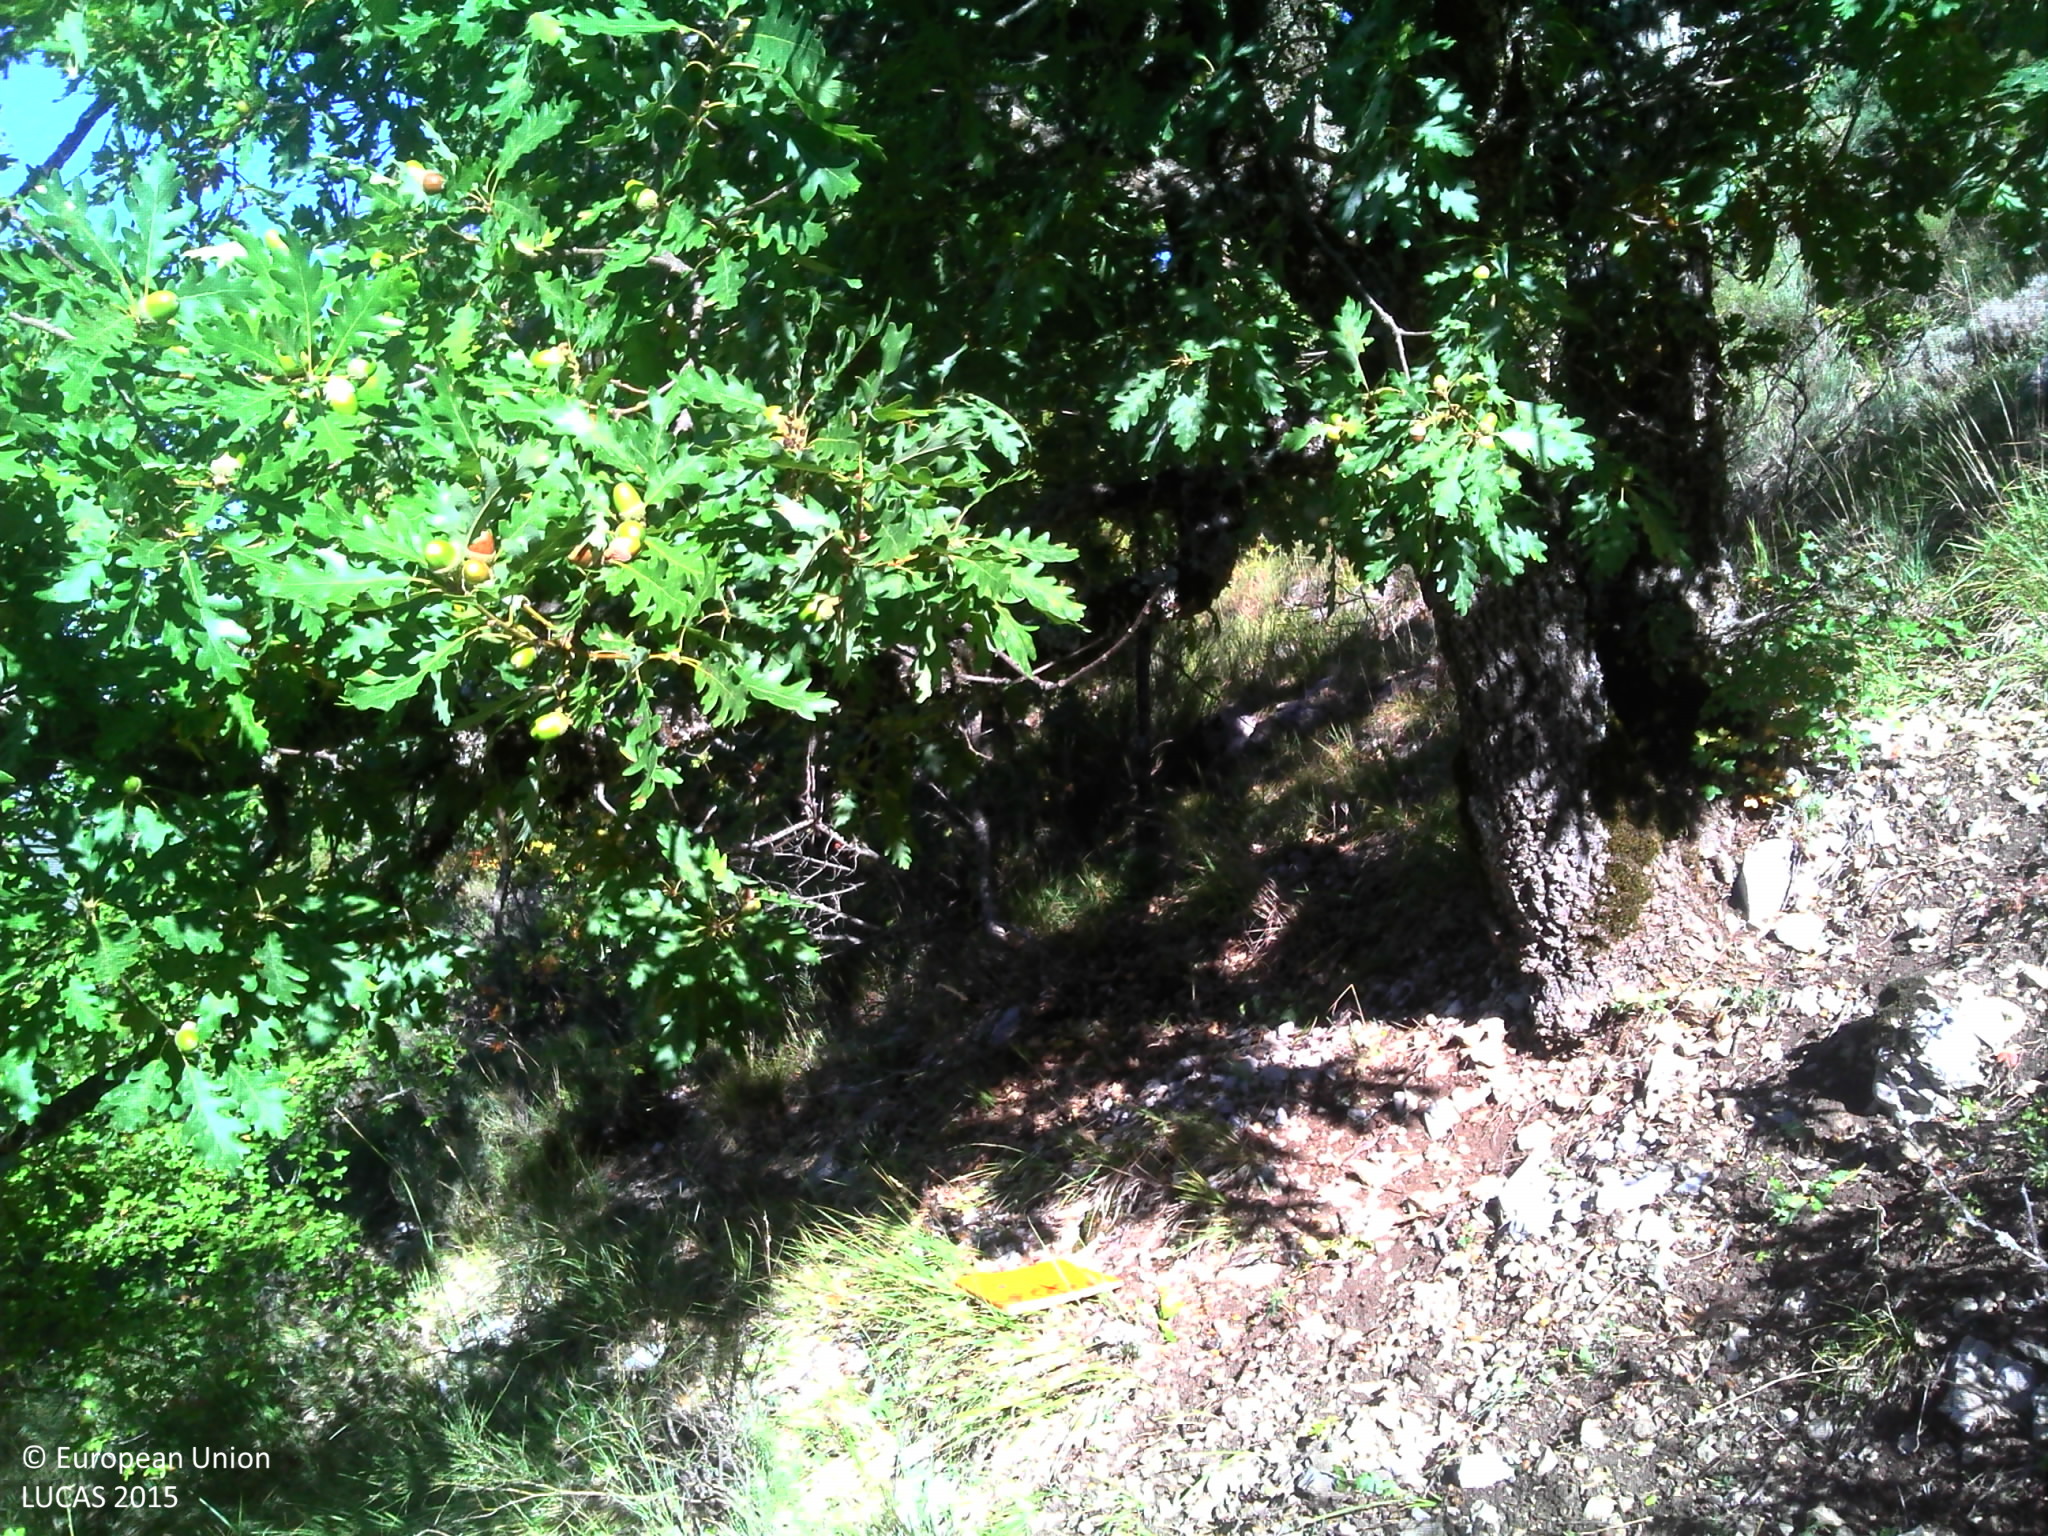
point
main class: Woodland
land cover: Broadleaved woodland
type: thermophilous deciduous forest
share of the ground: > 75 %
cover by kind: broadleaved forest trees 75 %, herbaceous plants 20 %, coniferous forest trees 5 %
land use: Semi-natural and natural areas not in use
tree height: > 5 m
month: September
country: FR
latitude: 44.3075
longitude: 5.5071
